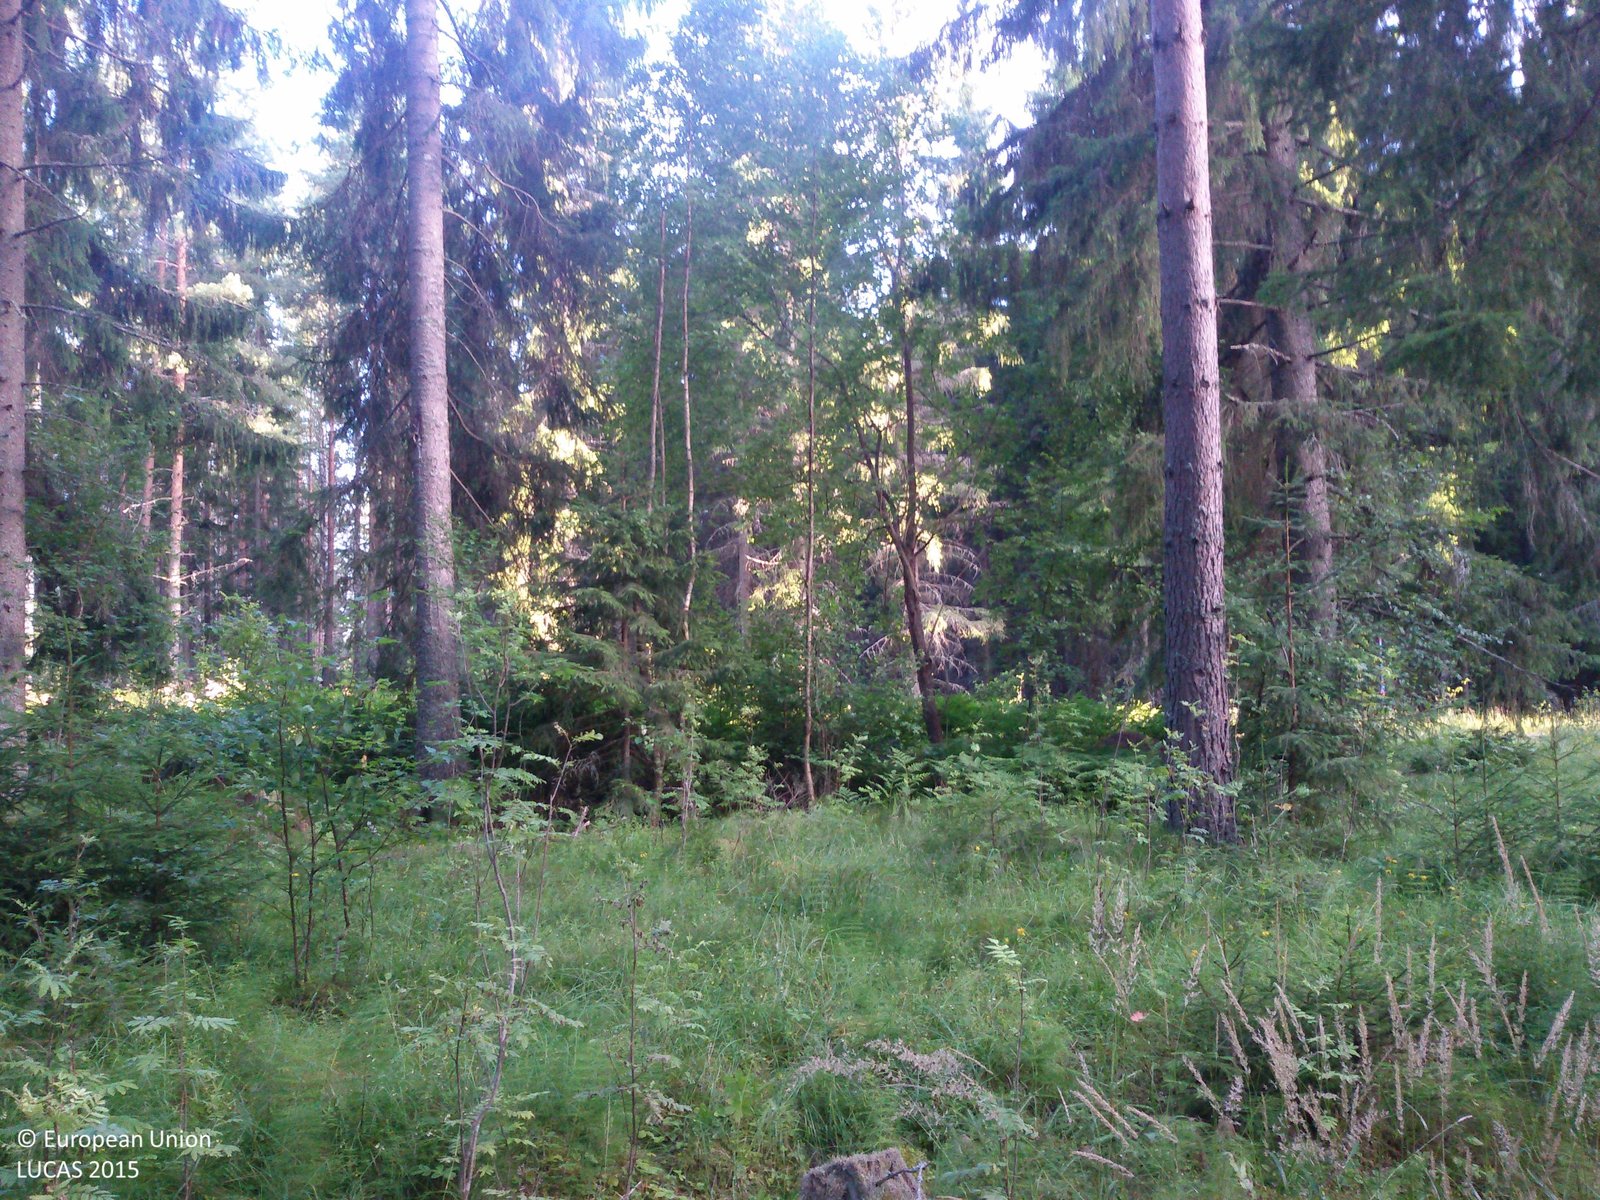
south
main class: Woodland
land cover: Spruce dominated coniferous woodland
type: boreal forest
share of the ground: 50 - 75 %
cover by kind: coniferous forest trees 60 %, herbaceous plants 20 %, broadleaved forest trees 10 %, lichens and mosses 10 %
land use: Forestry
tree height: > 5 m
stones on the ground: < 10 %
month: August
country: SE
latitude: 60.4408
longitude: 16.6219
